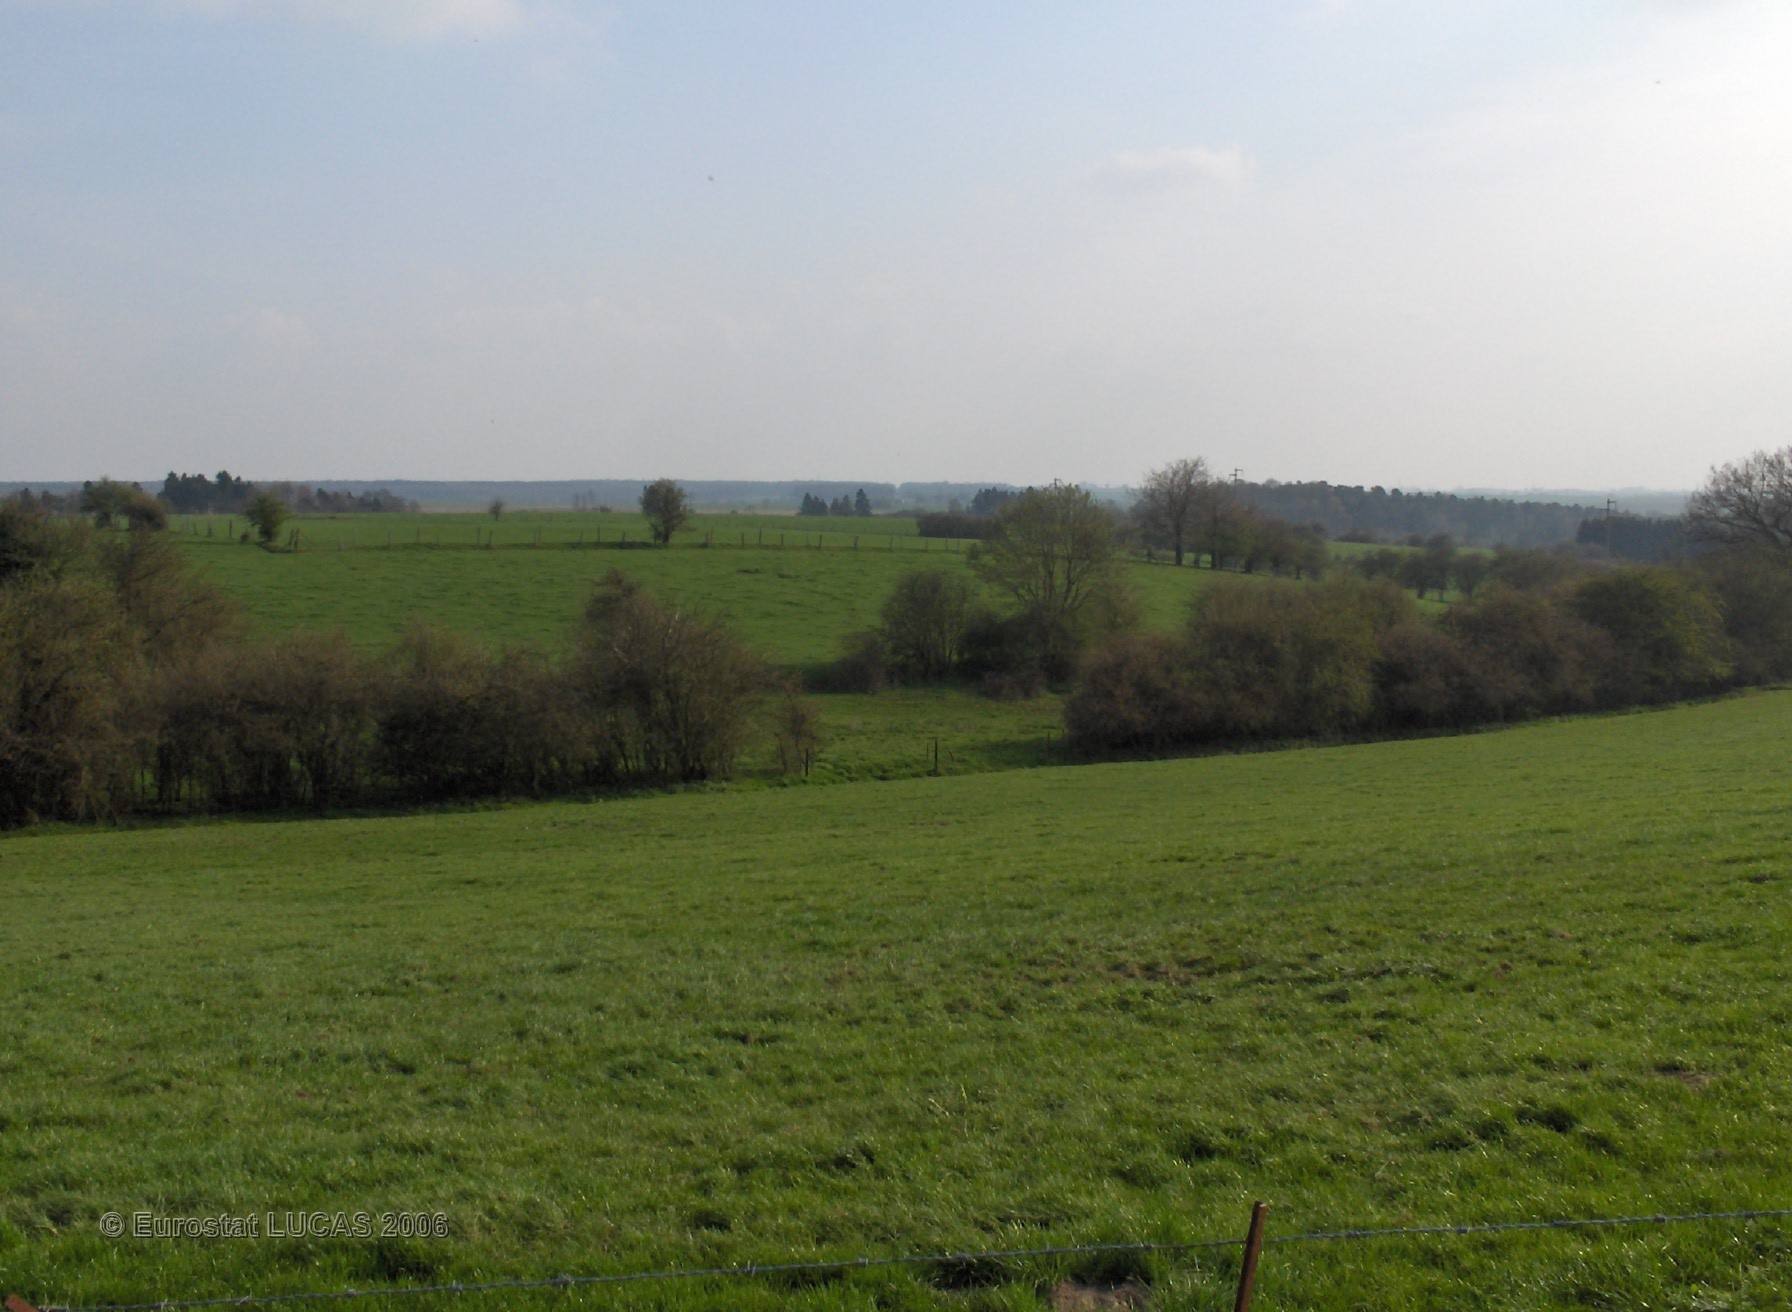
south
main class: Grassland
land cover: Grassland without tree/shrub cover
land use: Agriculture (excluding fallow land and kitchen gardens)
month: April
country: BE
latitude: 50.2531
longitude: 4.5684
